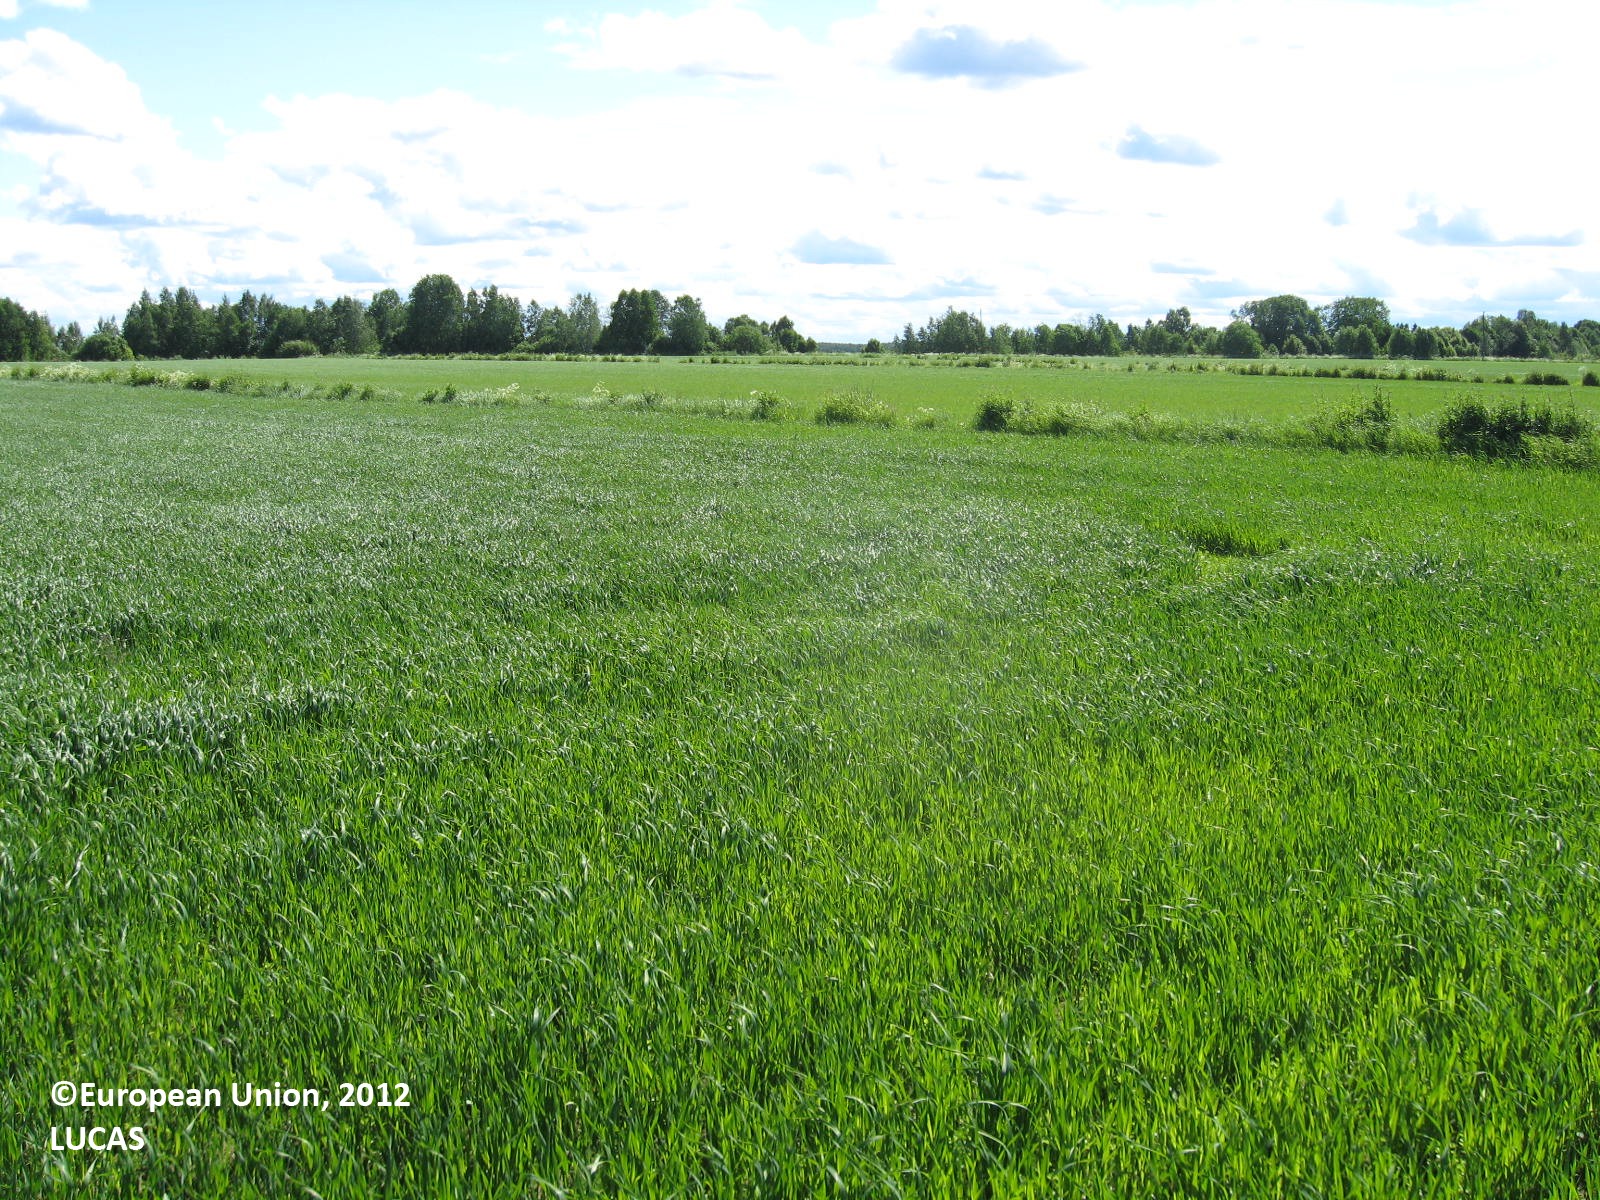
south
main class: Cropland
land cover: Oats
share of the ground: 50 - 75 %
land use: Agriculture (excluding fallow land and kitchen gardens)
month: June
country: FI
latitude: 62.7750
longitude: 22.6142
